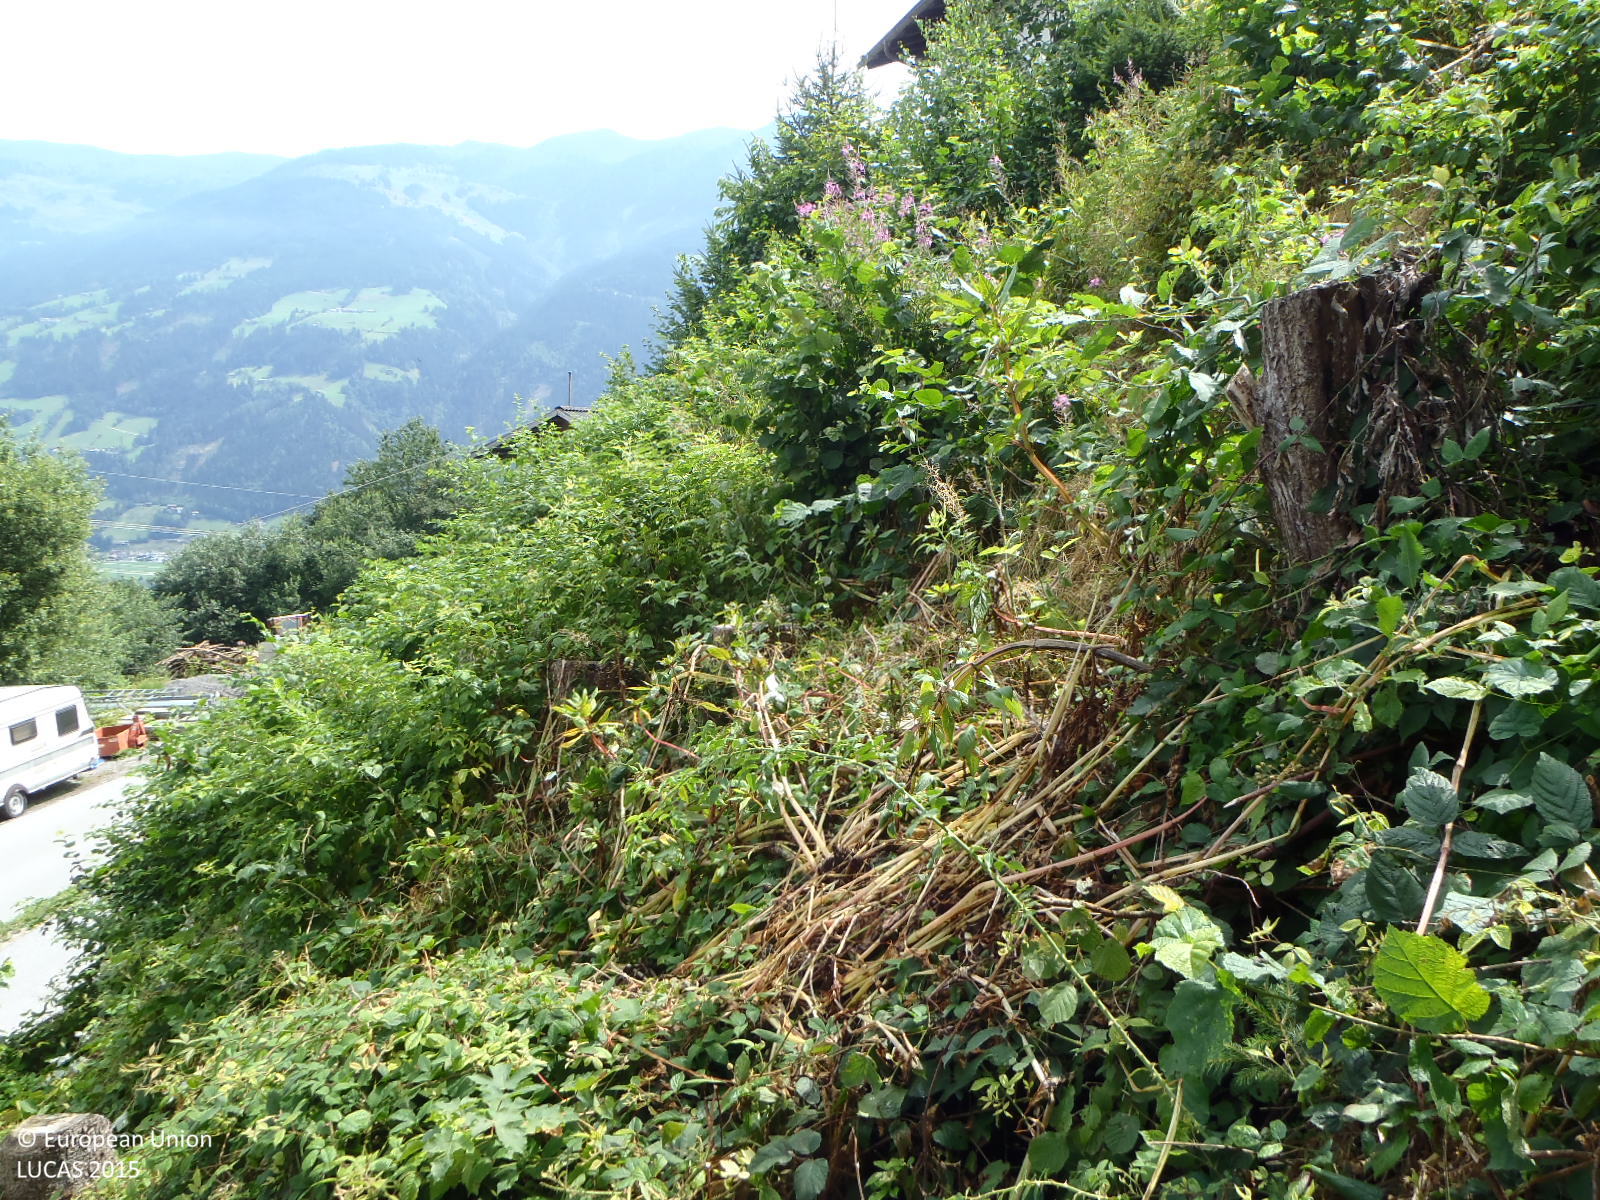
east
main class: Grassland
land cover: Grassland without tree/shrub cover
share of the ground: > 75 %
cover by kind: herbaceous plants 100 %
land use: Agriculture (excluding fallow land and kitchen gardens)
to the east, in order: Grassland without tree/shrub cover; Shrubland without tree cover; Artificial constructions in urban areas; Grassland without tree/shrub cover; Apple fruit; Artificial constructions in urban areas; Grassland without tree/shrub cover; Fences; Grassland without tree/shrub cover; Electric lines; Grassland without tree/shrub cover; Artificial constructions in urban areas; Spruce dominated coniferous woodland; Broadleaved woodland; Grassland with sparse tree/shrub cover; Spruce dominated coniferous woodland
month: July
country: AT
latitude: 47.3261
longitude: 11.8377
